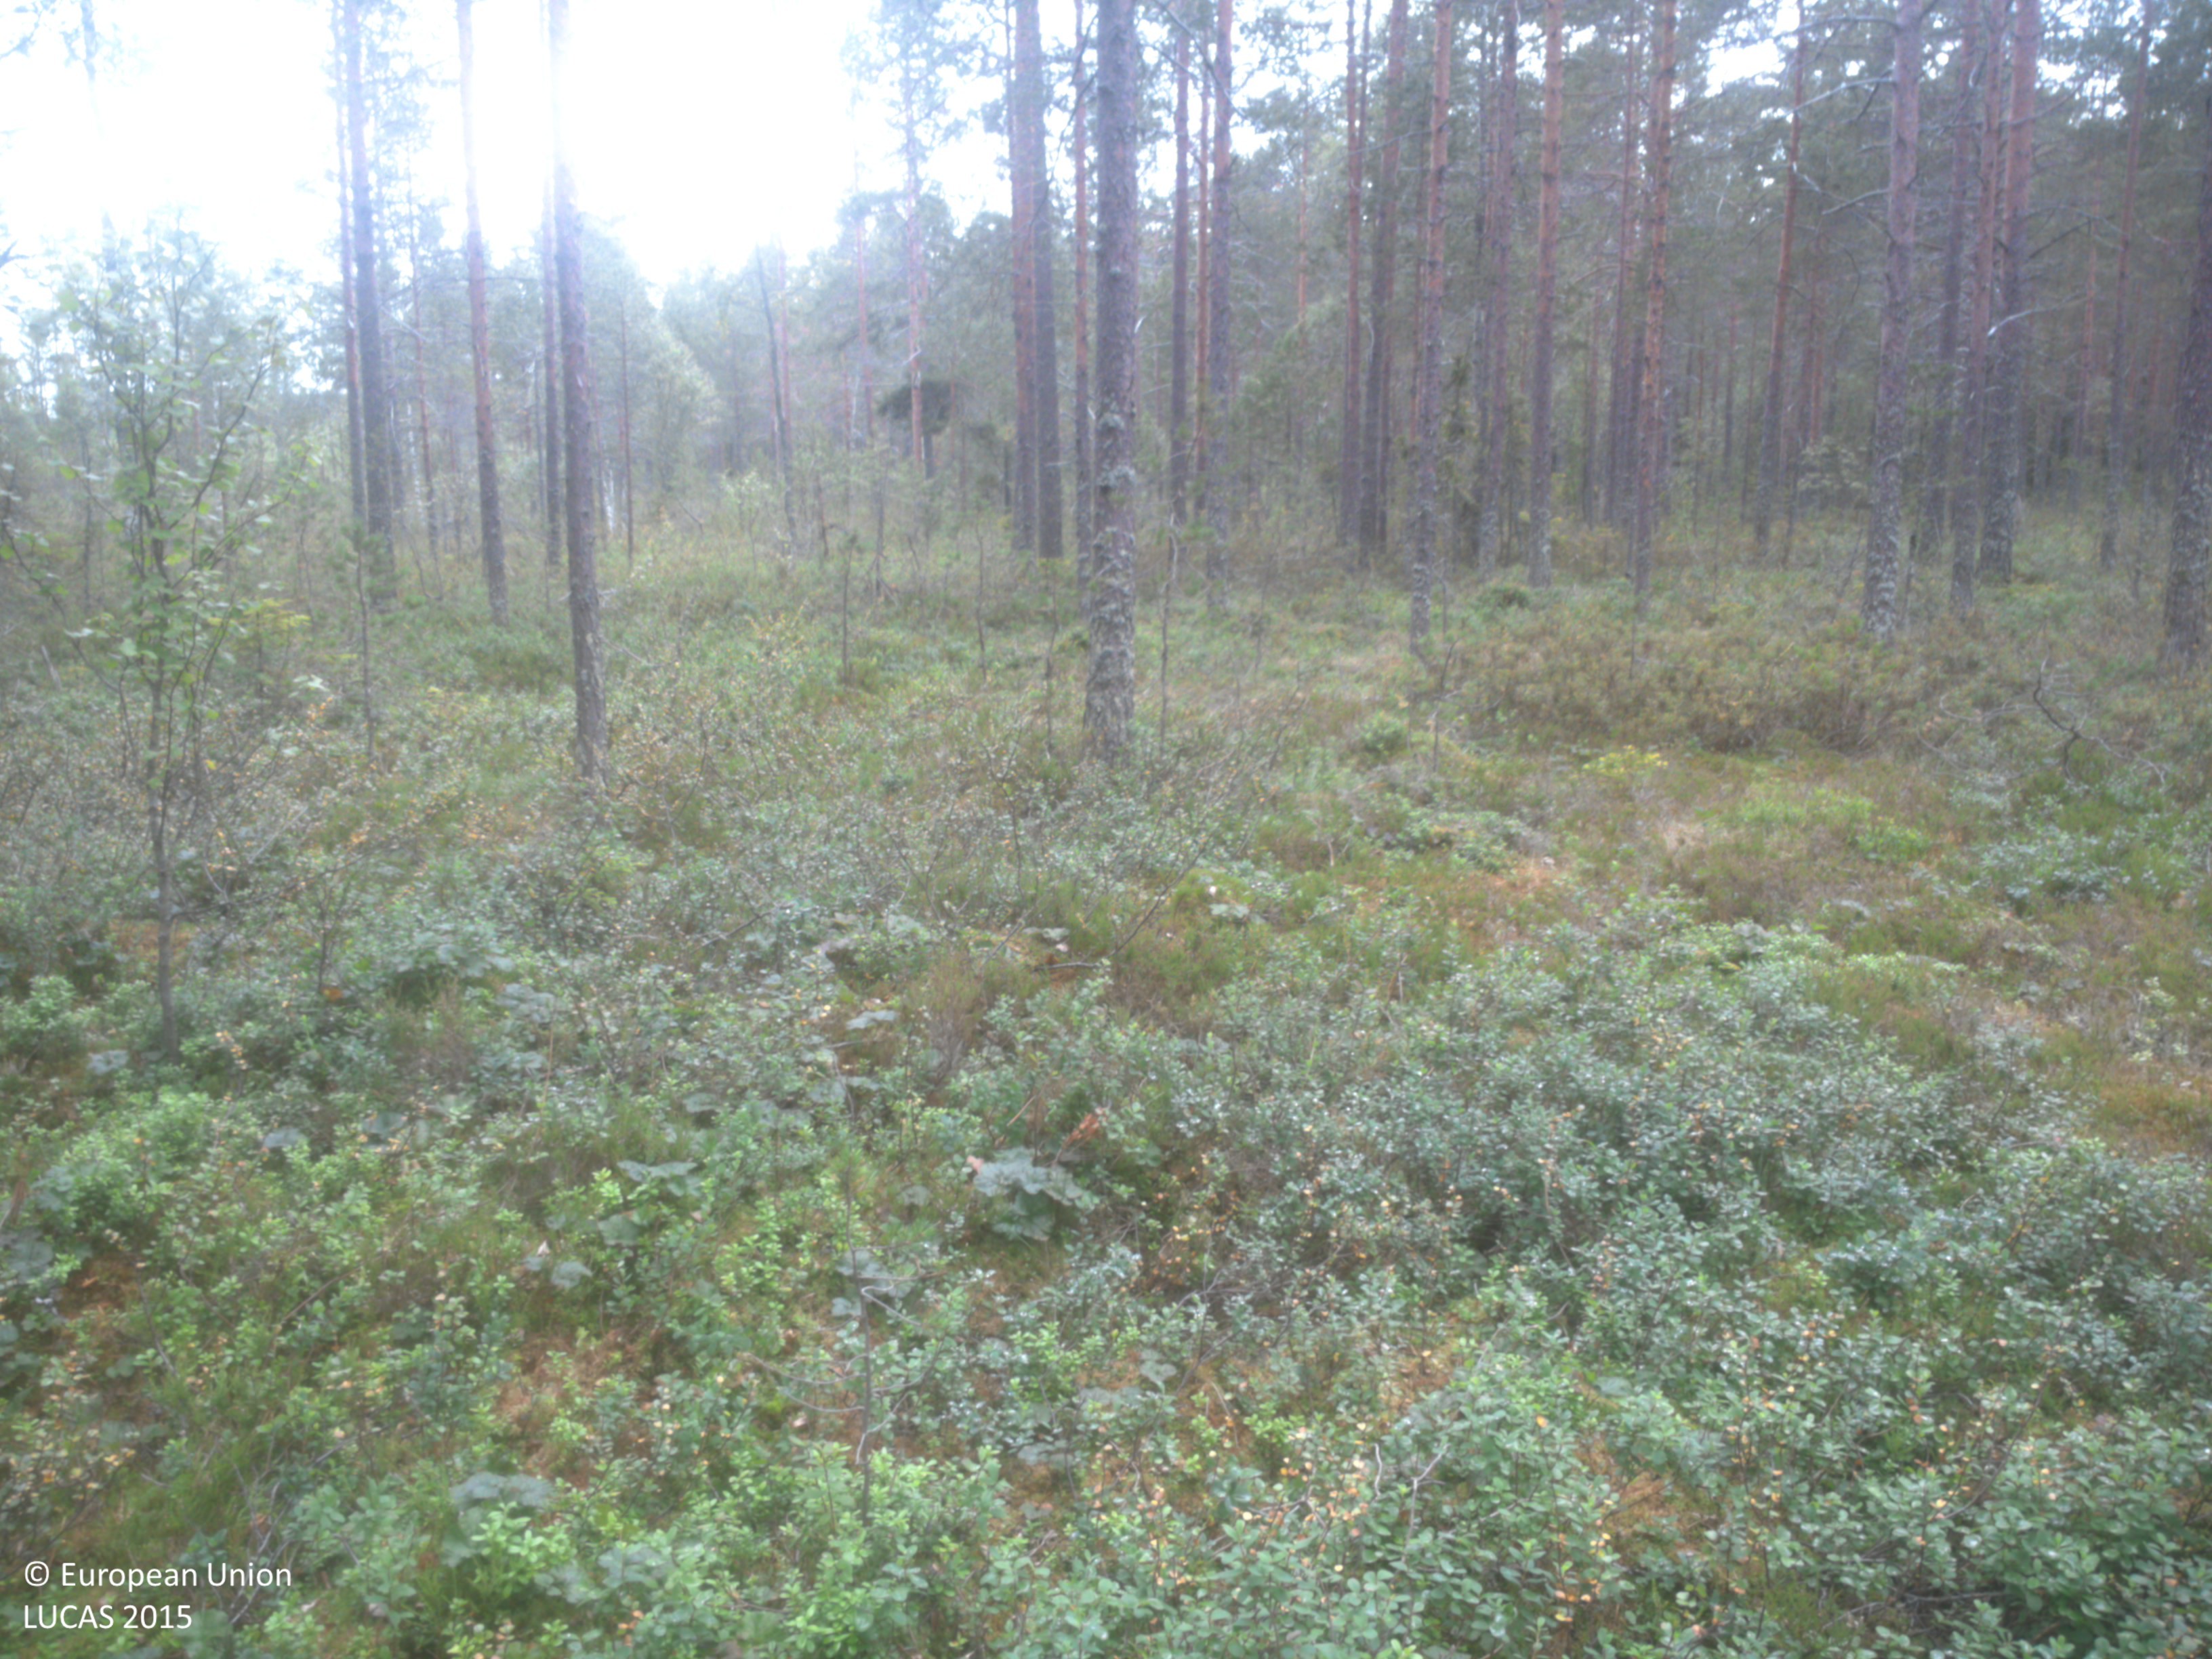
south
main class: Woodland
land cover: Pine dominated mixed woodland
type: boreal forest
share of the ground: 50 - 75 %
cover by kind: shrubs 45 %, coniferous forest trees 30 %, broadleaved forest trees 20 %, lichens and mosses 5 %
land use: Forestry
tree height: > 5 m
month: August
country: SE
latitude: 63.7225
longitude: 19.9210
